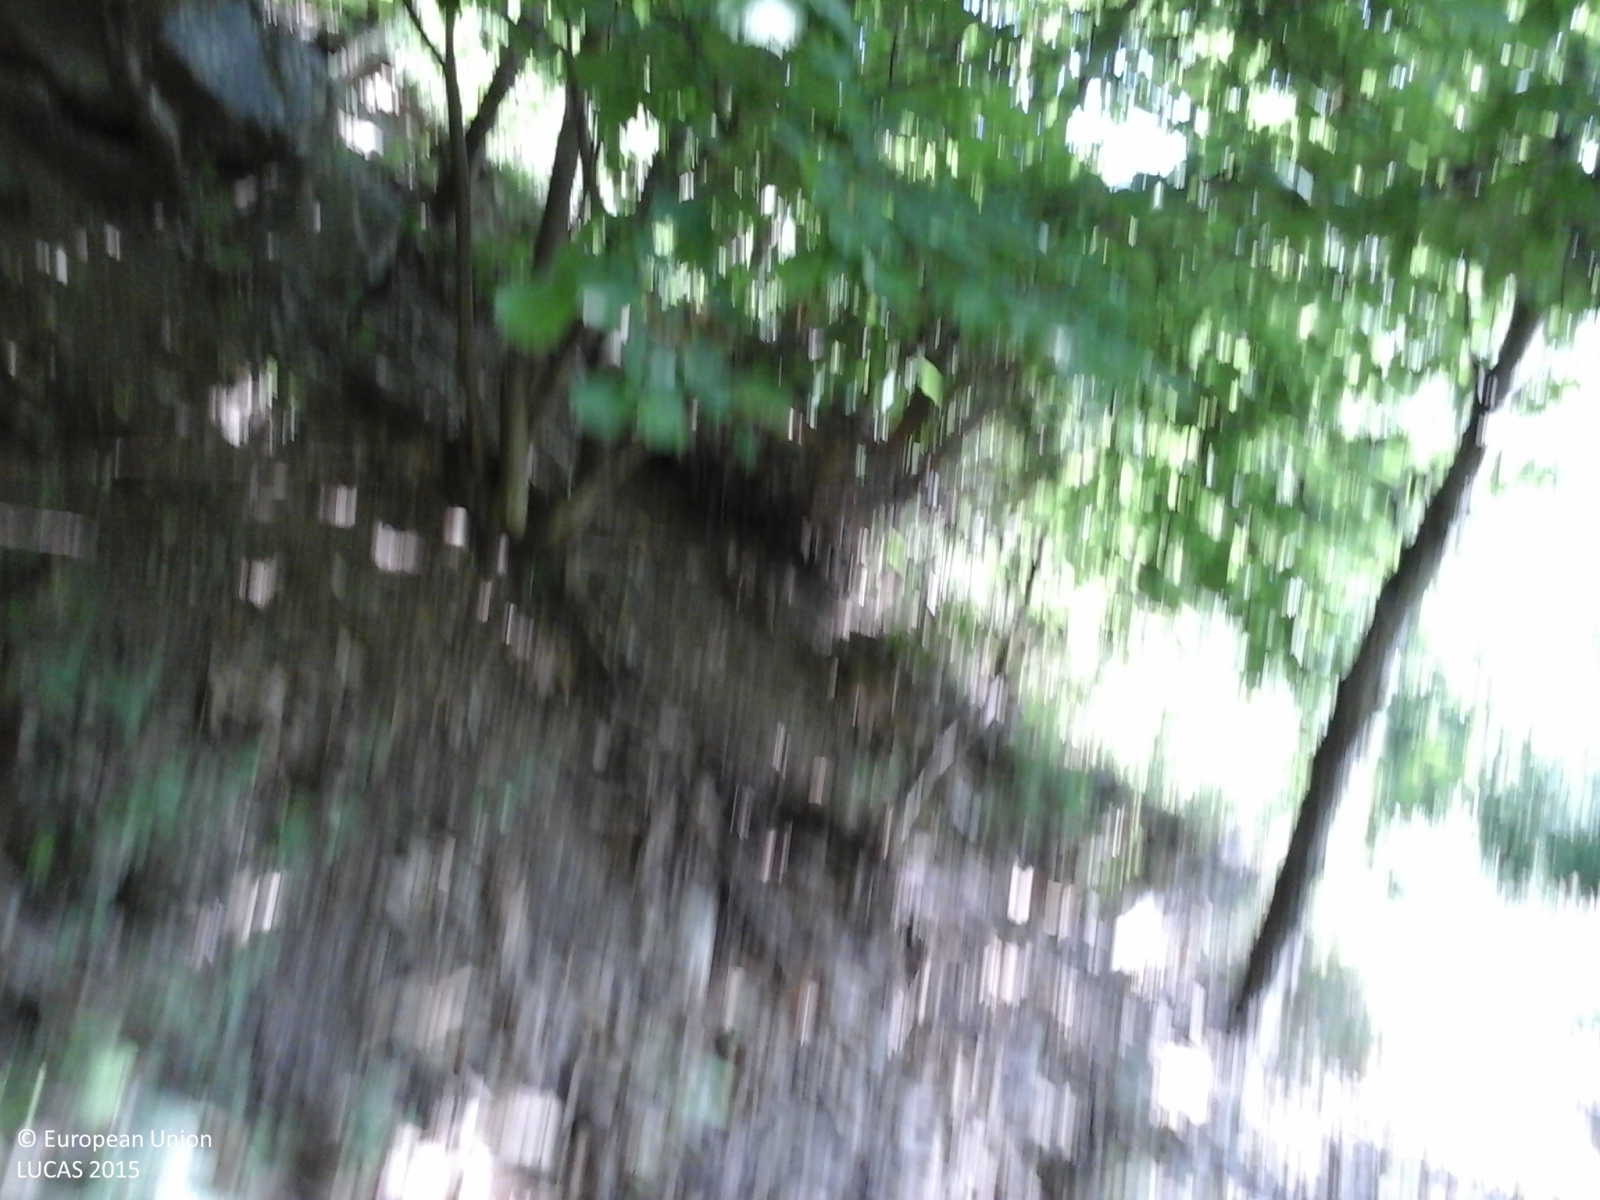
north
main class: Woodland
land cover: Broadleaved woodland
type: mesophytic deciduous forest
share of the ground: > 75 %
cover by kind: broadleaved forest trees 100 %
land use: Forestry
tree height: > 5 m
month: July
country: IT
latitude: 44.2977
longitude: 7.3109
